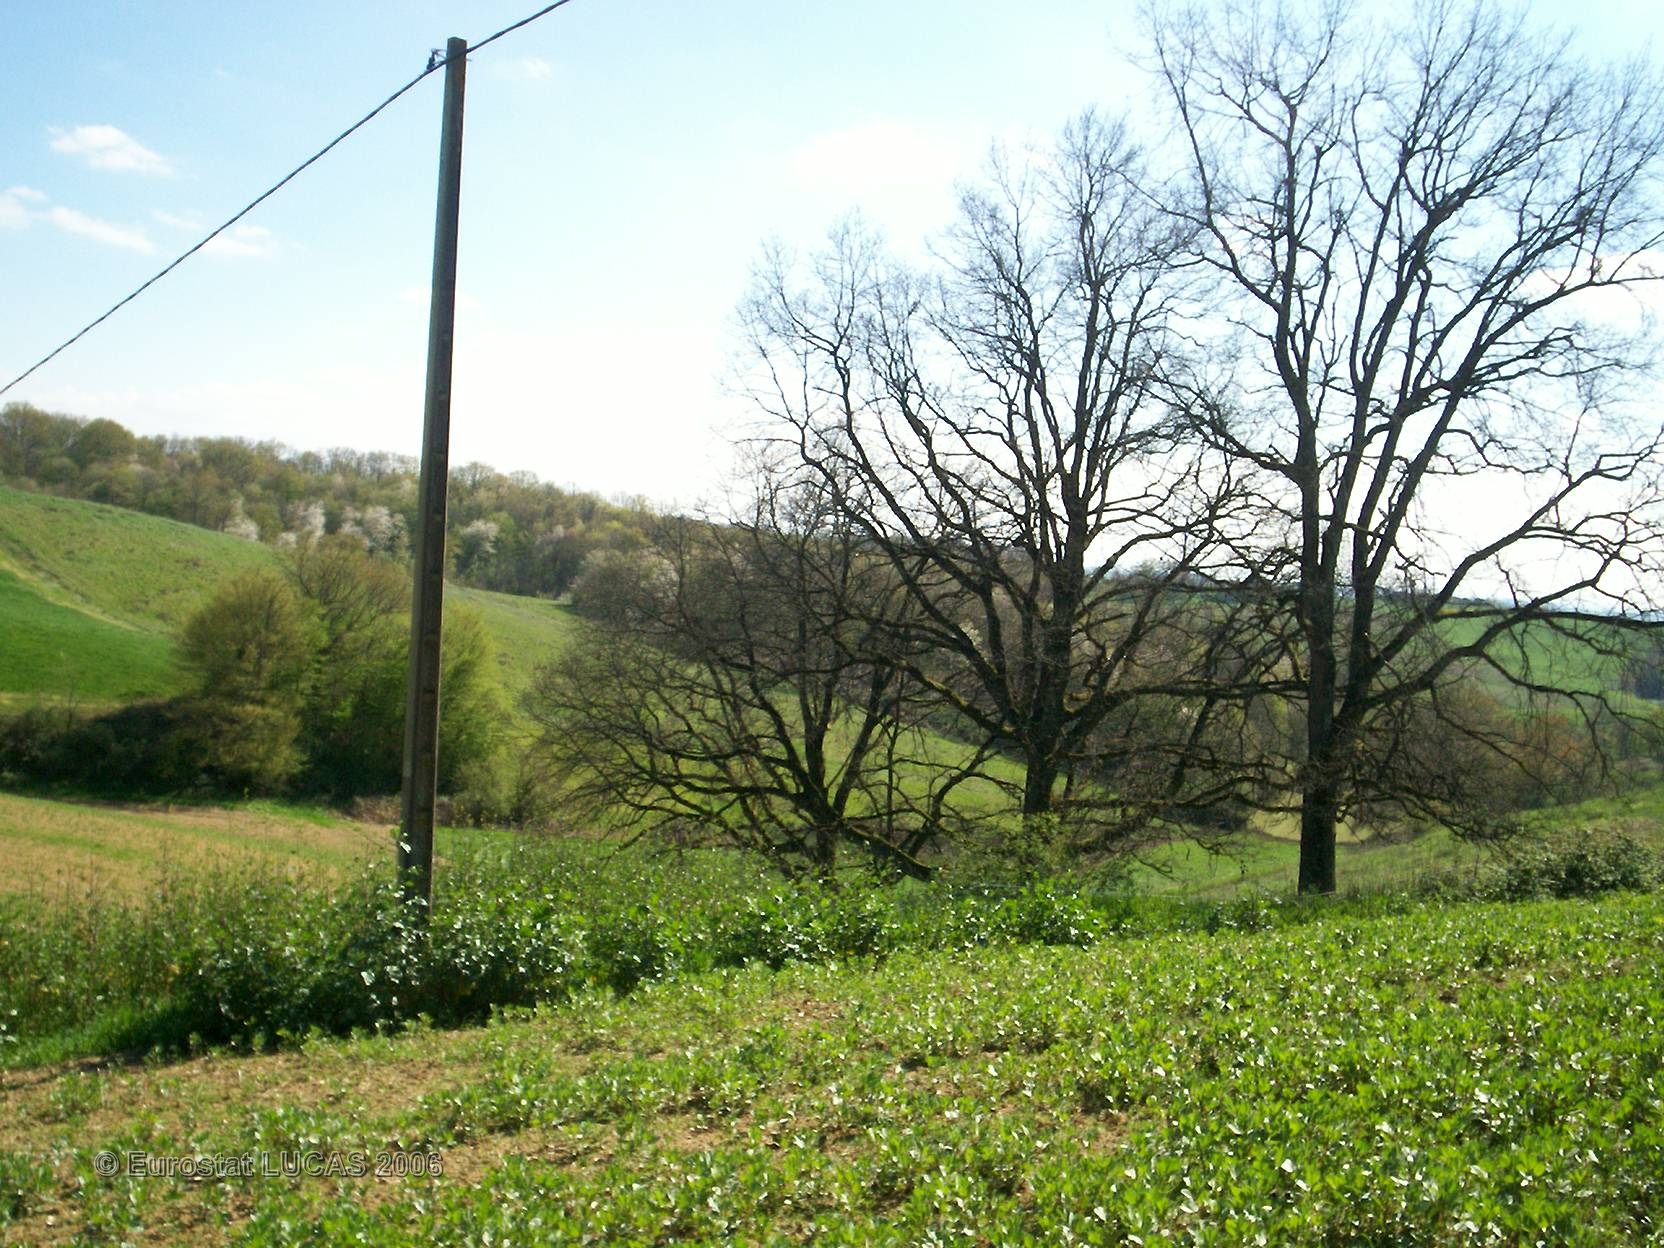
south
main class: Cropland
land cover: Dry pulses
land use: Agriculture (excluding fallow land and kitchen gardens)
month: April
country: FR
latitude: 43.5436
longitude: 0.2311
